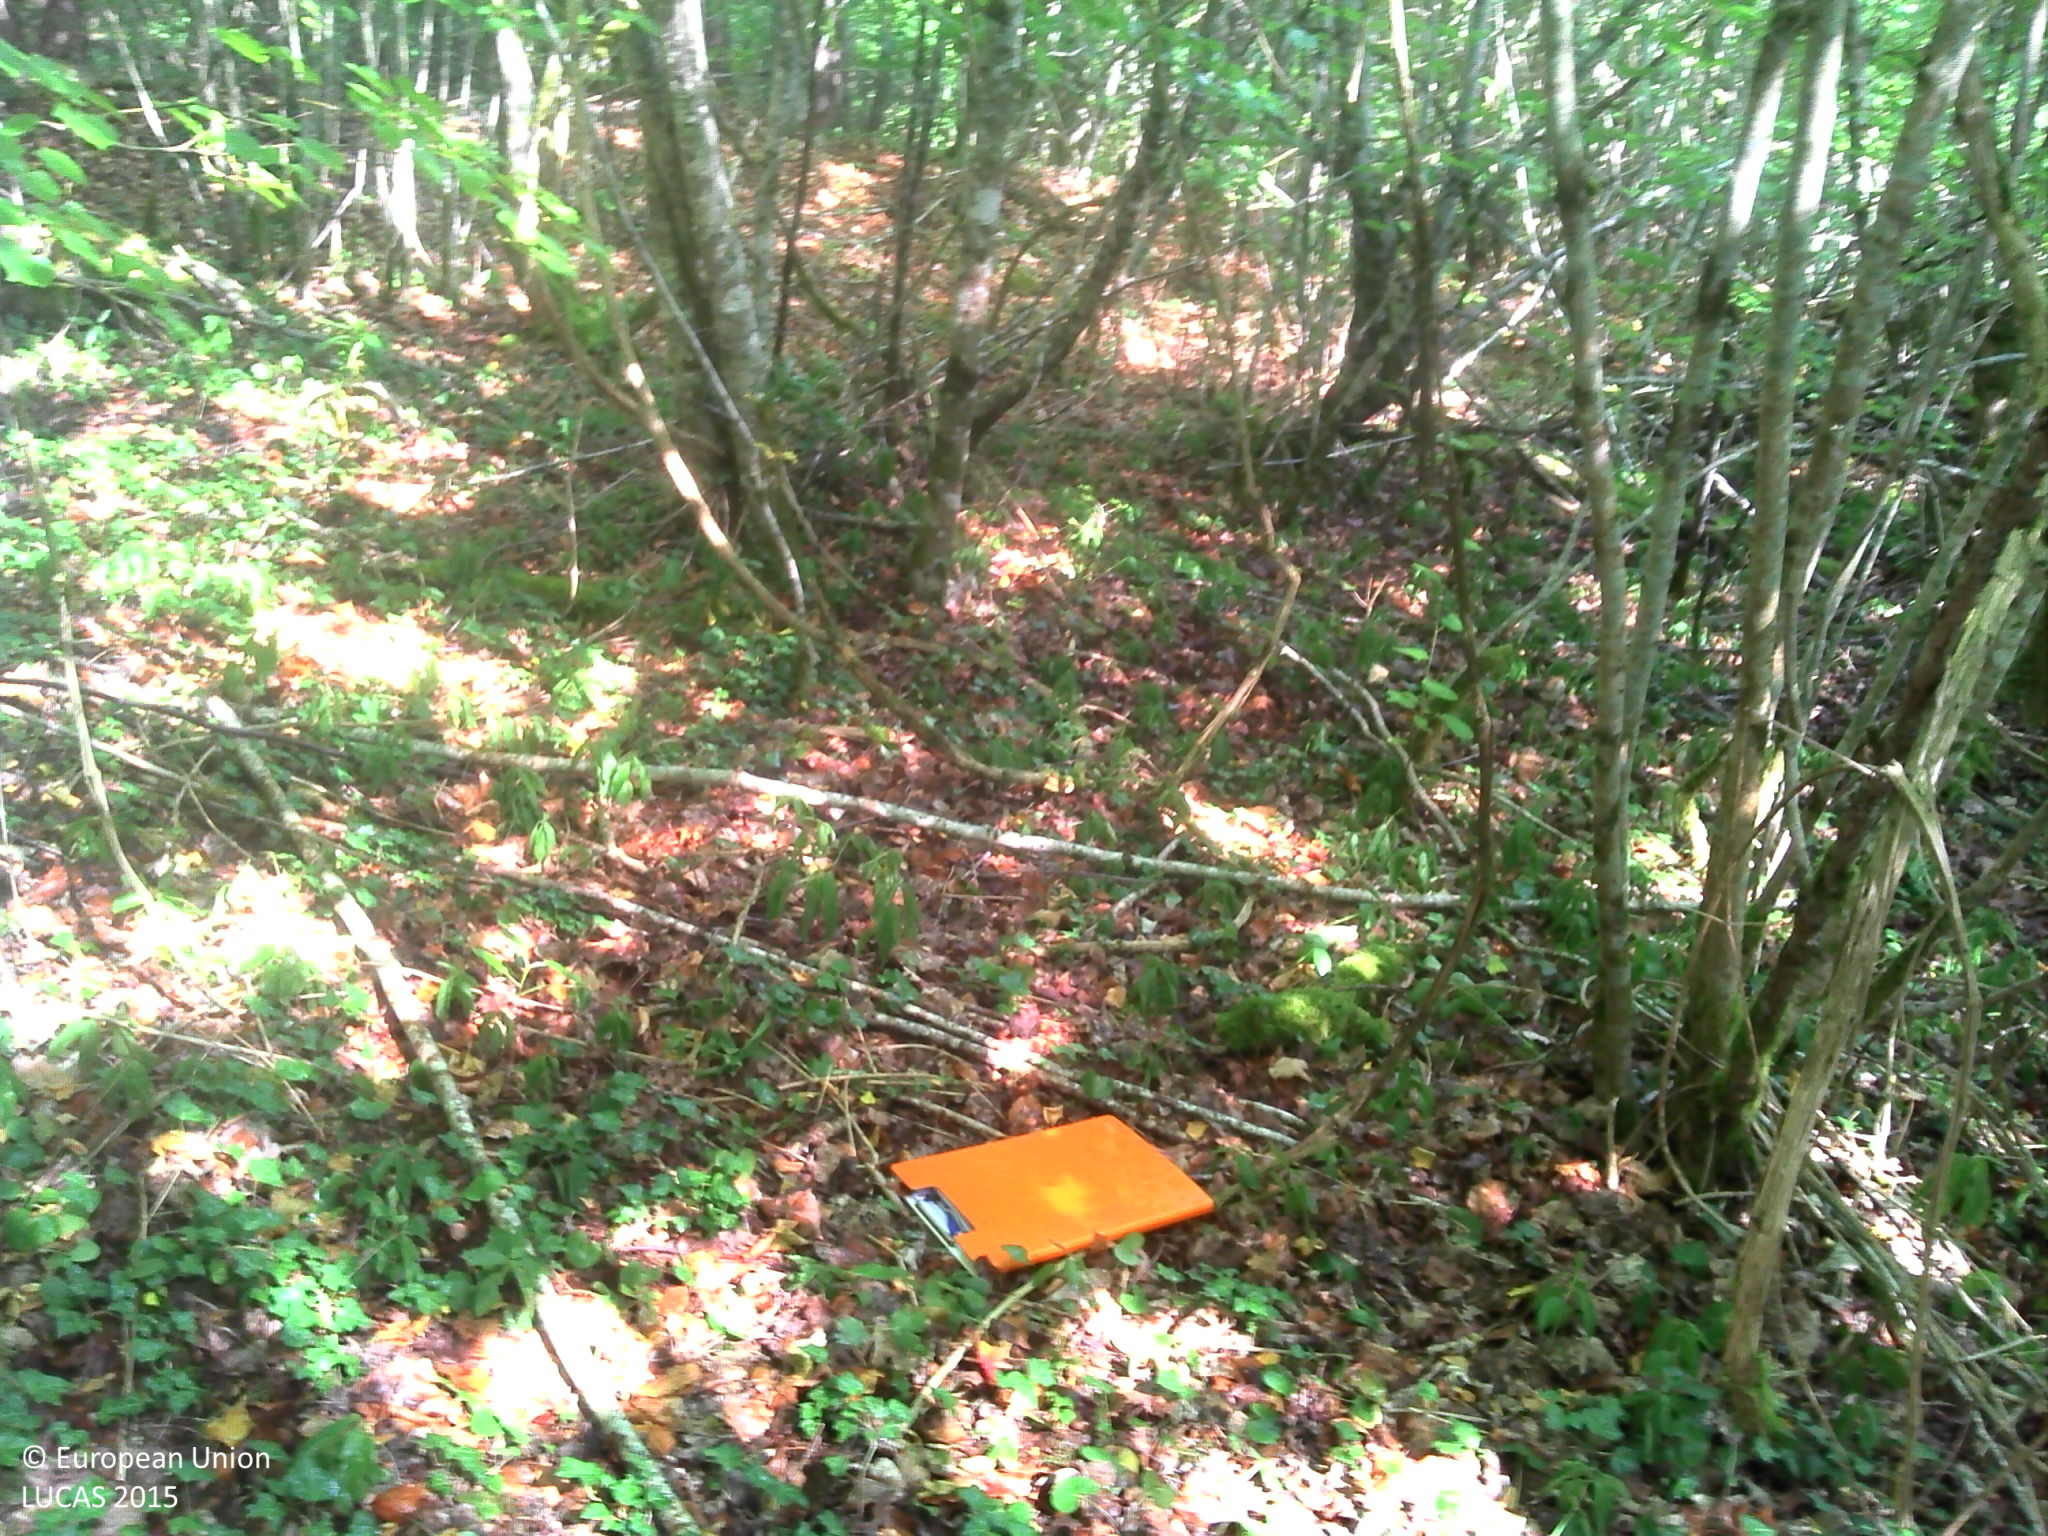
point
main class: Woodland
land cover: Broadleaved woodland
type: beech forest
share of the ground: > 75 %
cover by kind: broadleaved forest trees 85 %, coniferous forest trees 5 %, herbaceous plants 5 %, lichens and mosses 5 %
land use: Forestry
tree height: > 5 m
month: July
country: FR
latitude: 47.9958
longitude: 4.8661
